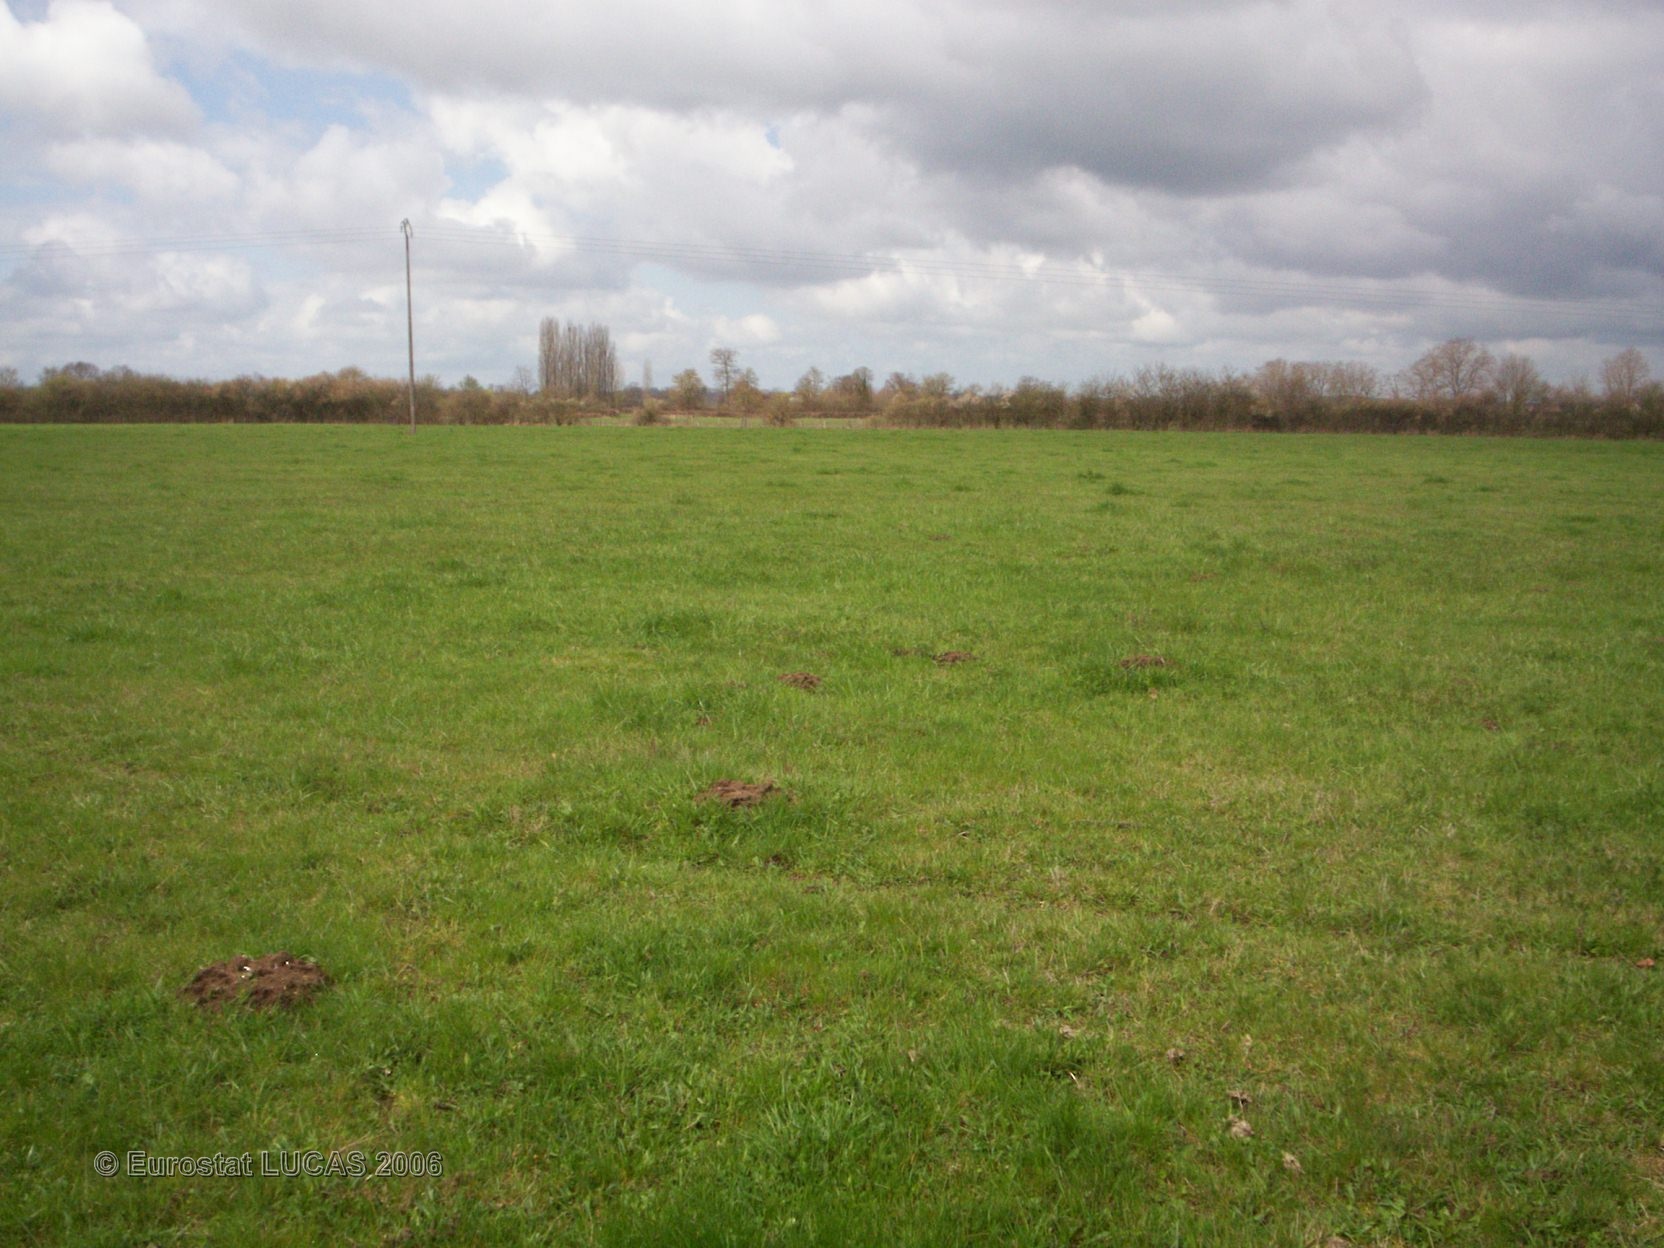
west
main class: Grassland
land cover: Grassland without tree/shrub cover
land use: Agriculture (excluding fallow land and kitchen gardens)
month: April
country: FR
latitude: 46.8323
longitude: 3.0874
